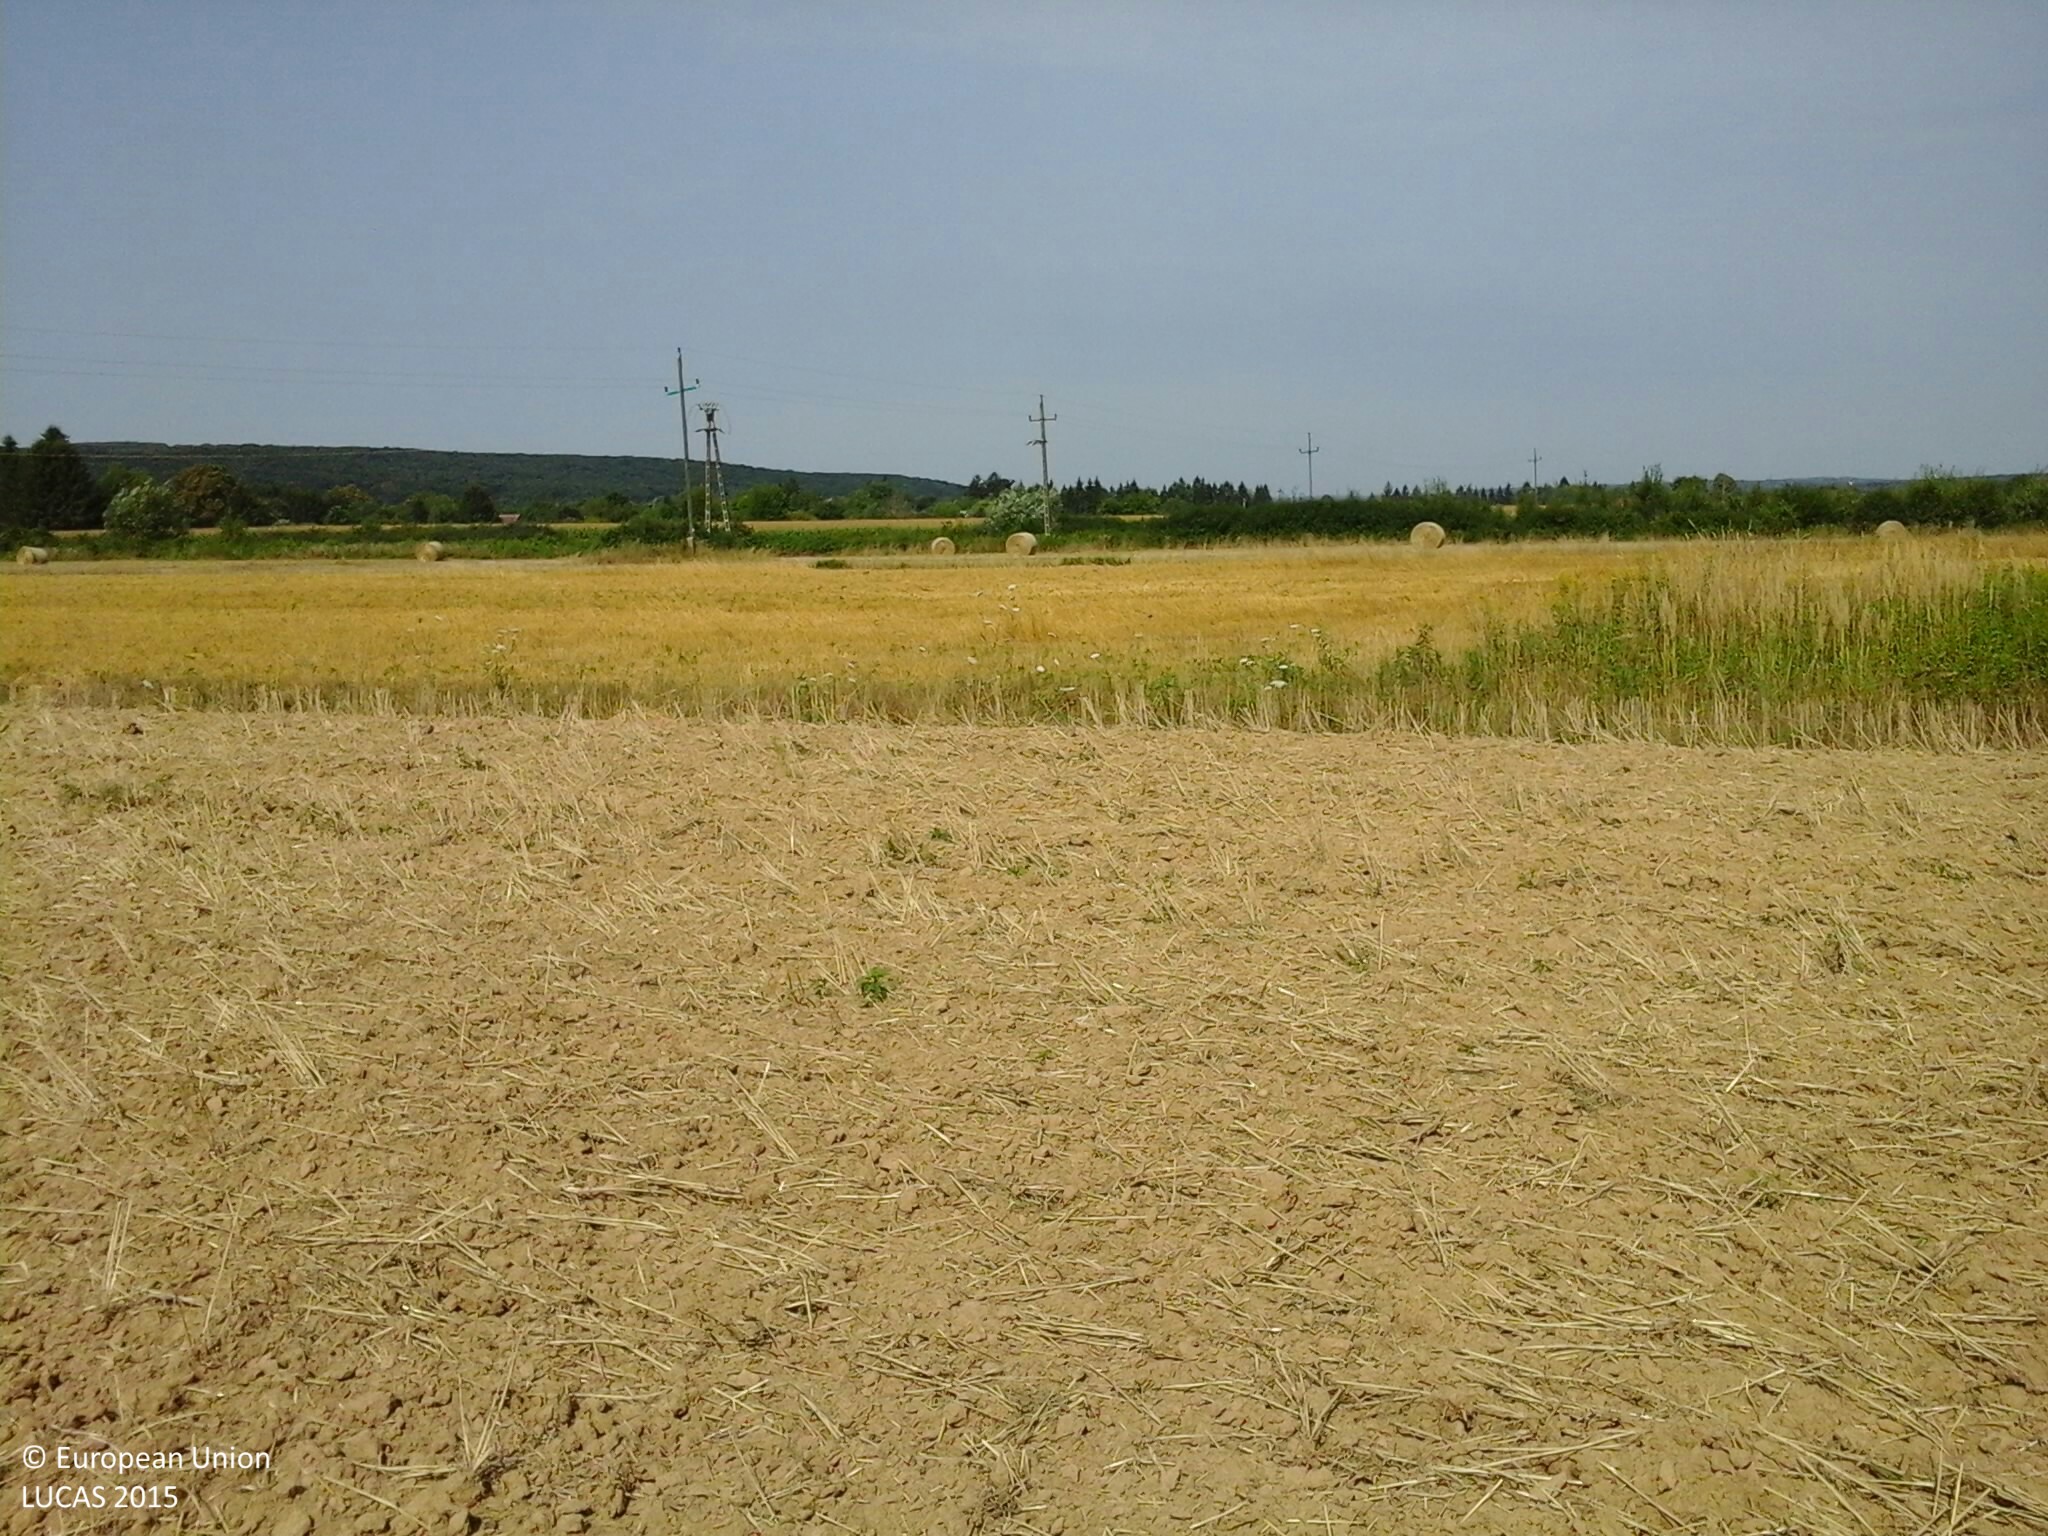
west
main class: Cropland
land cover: Common wheat
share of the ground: < 10 %
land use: Agriculture (excluding fallow land and kitchen gardens)
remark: Harvested field
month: July
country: HU
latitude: 46.8107
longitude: 16.3838
